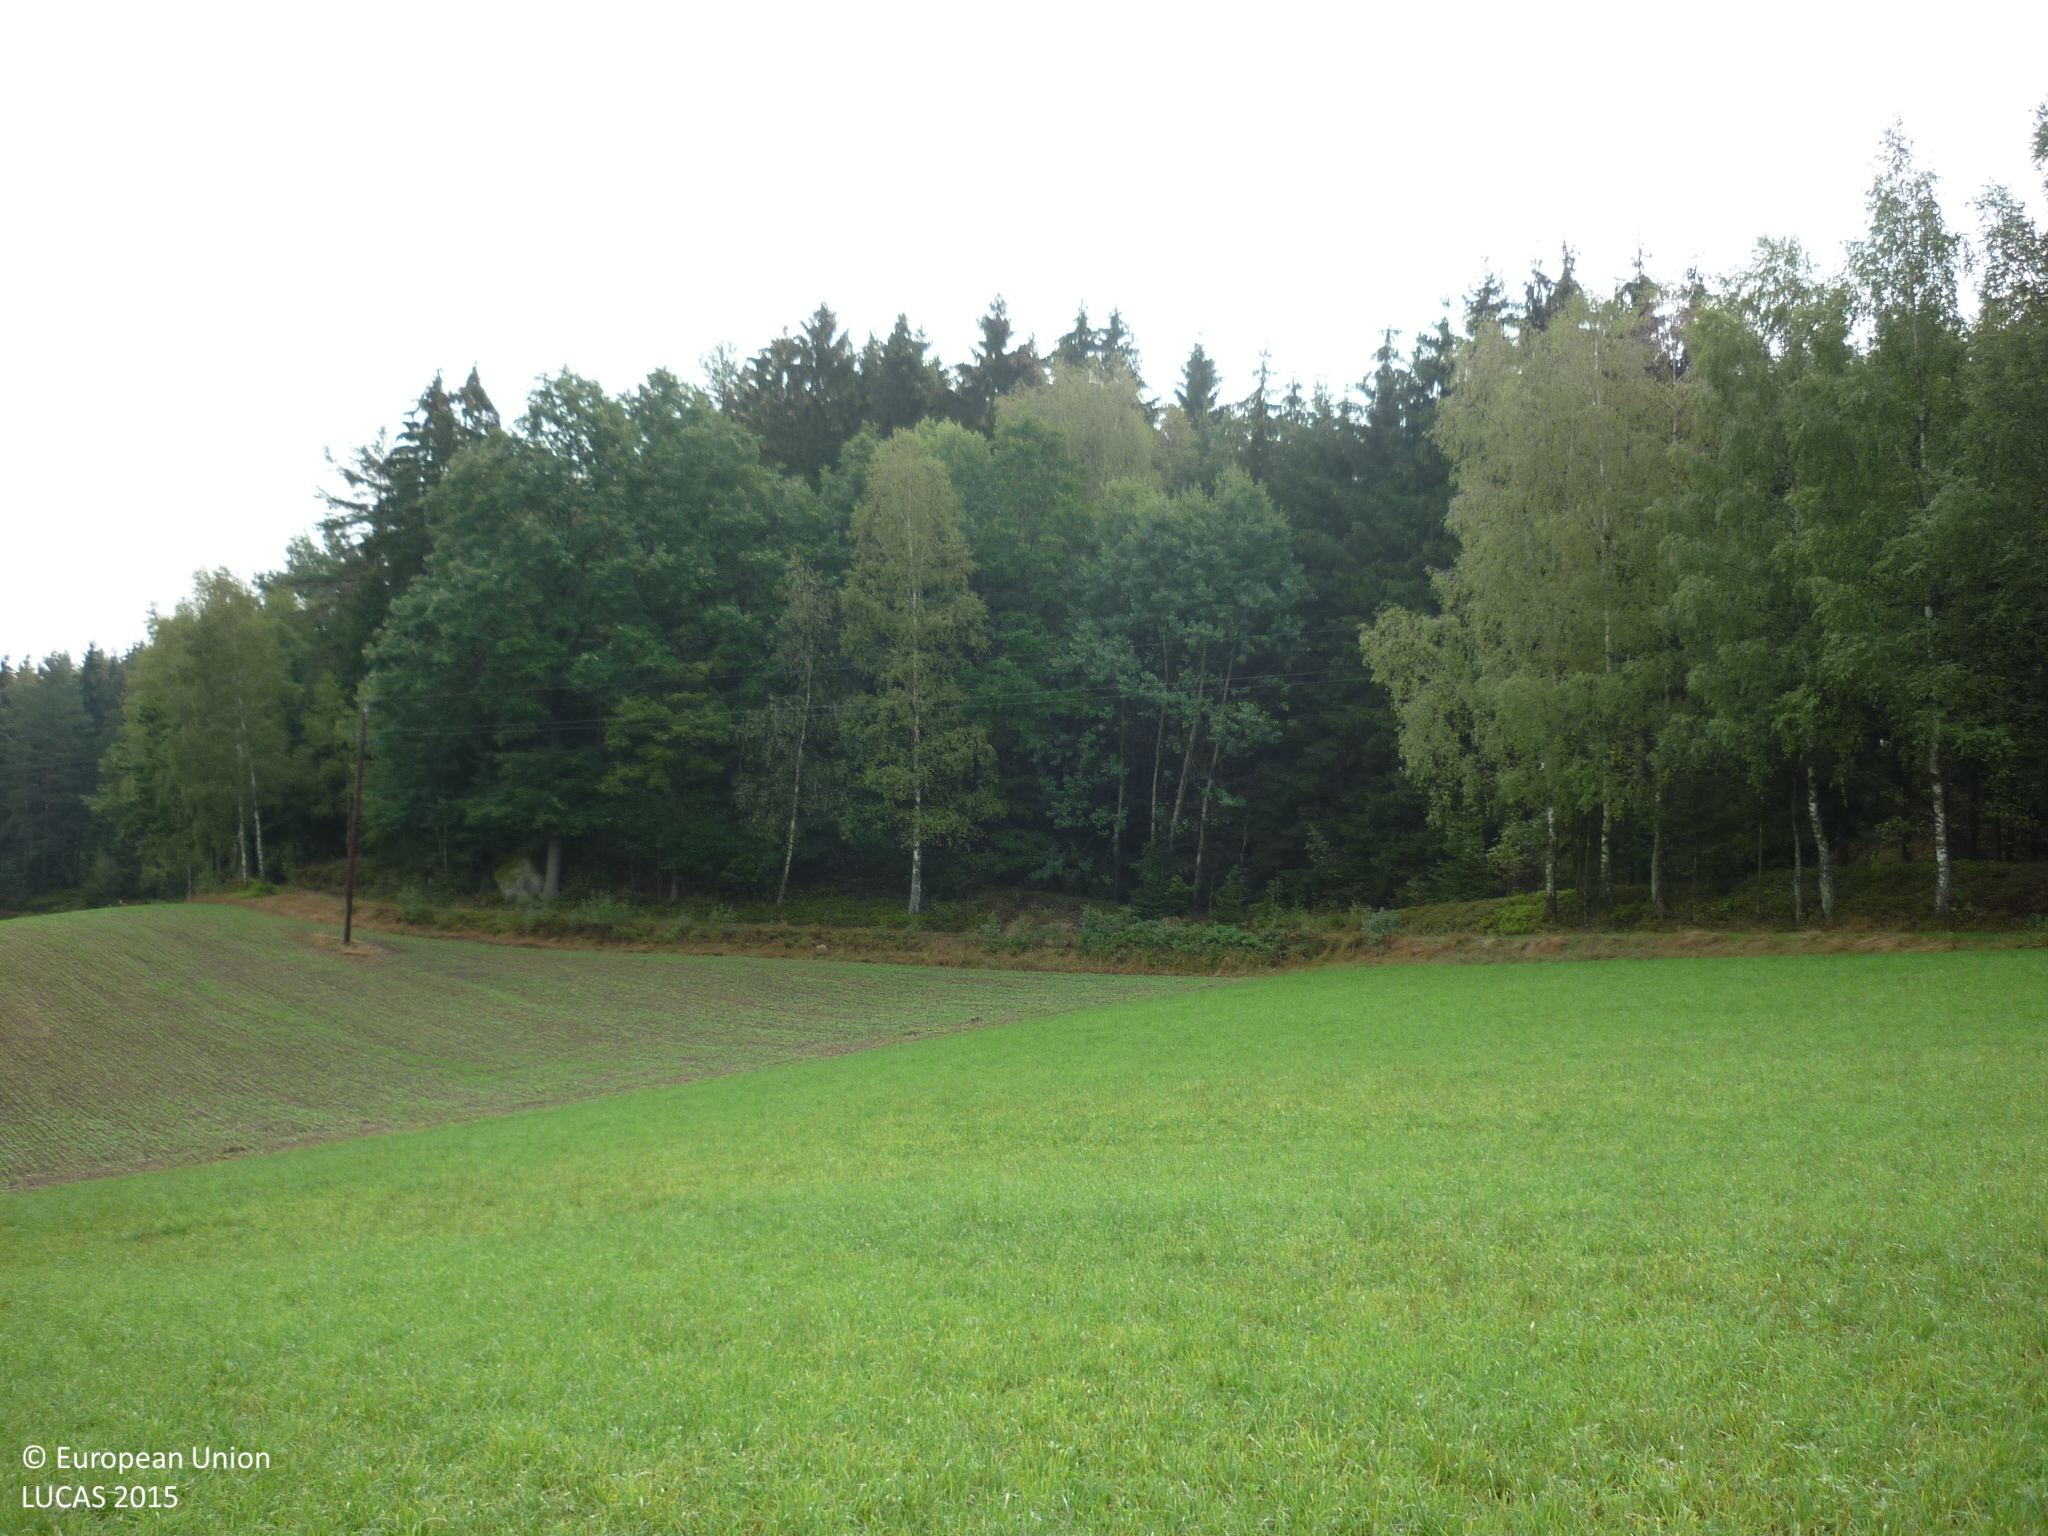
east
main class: Cropland
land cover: Other leguminous and mixtures for fodder
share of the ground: > 75 %
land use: Agriculture (excluding fallow land and kitchen gardens)
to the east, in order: Other leguminous and mixtures for fodder; Lucerne; Electric lines; Lucerne; Abandoned hedges; Tracks; Broadleaved woodland; Spruce dominated coniferous woodland; Tracks; Spruce dominated coniferous woodland
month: September
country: AT
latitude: 48.9567
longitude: 15.0142
